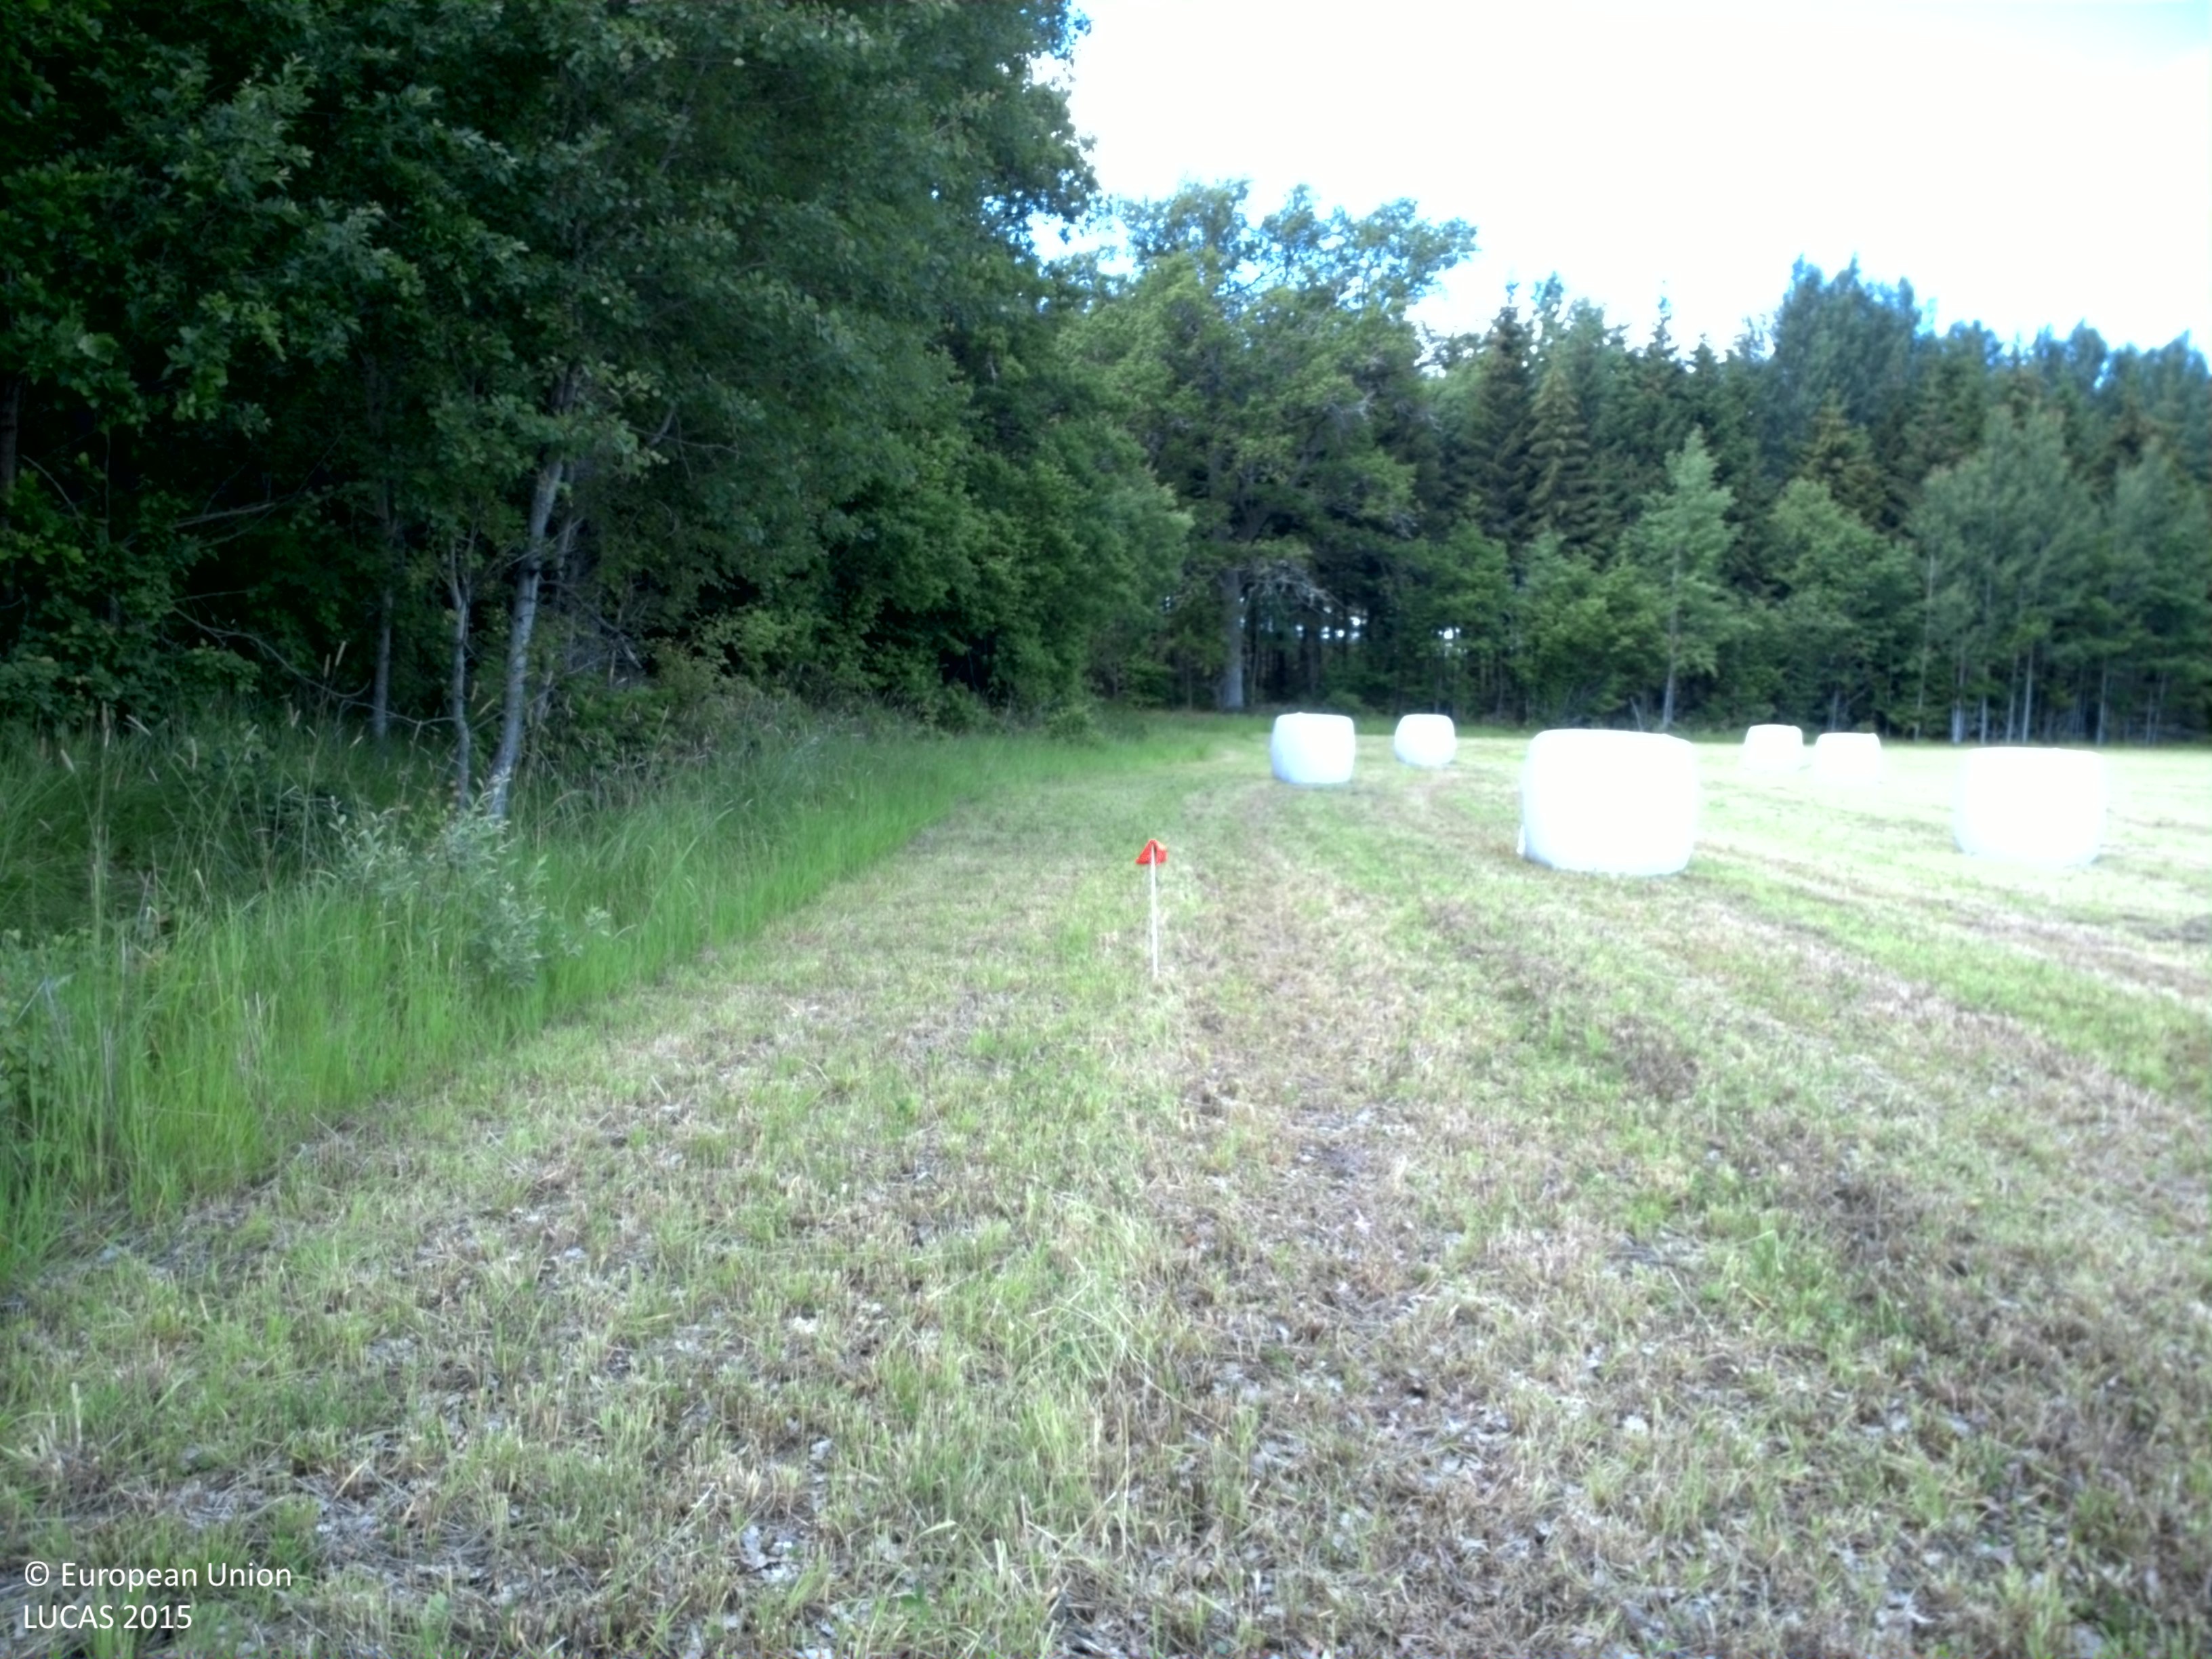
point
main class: Cropland
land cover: Temporary grasslands
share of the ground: > 75 %
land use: Agriculture (excluding fallow land and kitchen gardens)
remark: Harvested field
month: June
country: SE
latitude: 58.4468
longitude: 16.3867
